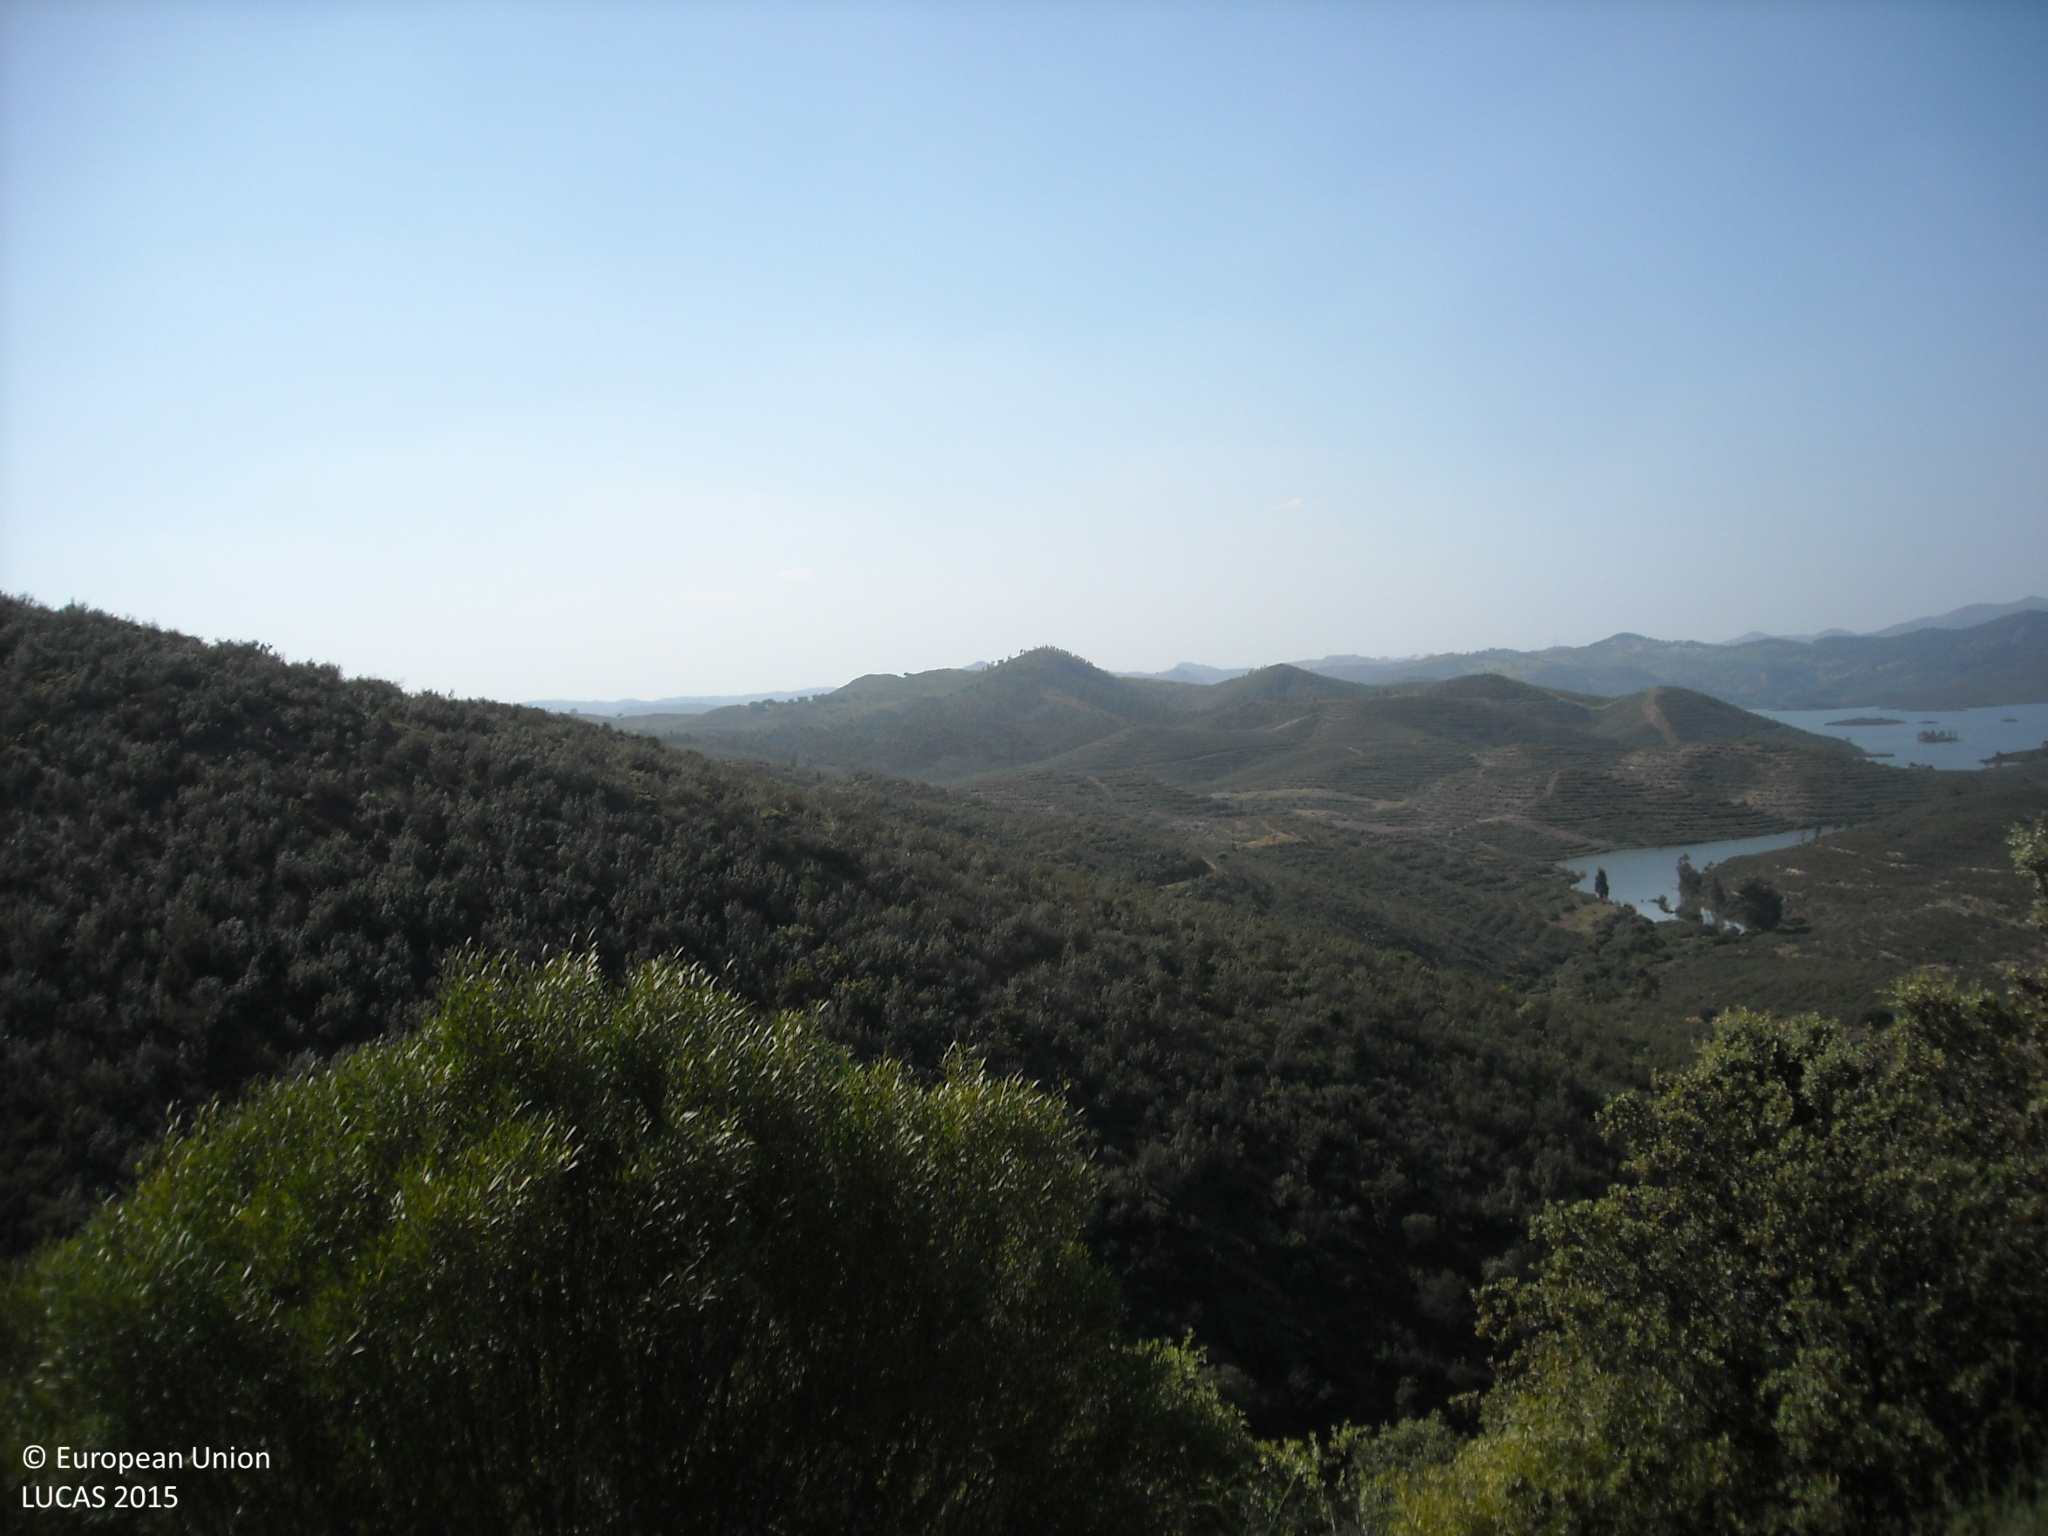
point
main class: Shrubland
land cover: Shrubland without tree cover
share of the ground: > 75 %
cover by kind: shrubs 75 %, herbaceous plants 25 %
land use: Semi-natural and natural areas not in use
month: April
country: ES
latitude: 37.6458
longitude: -6.4822
